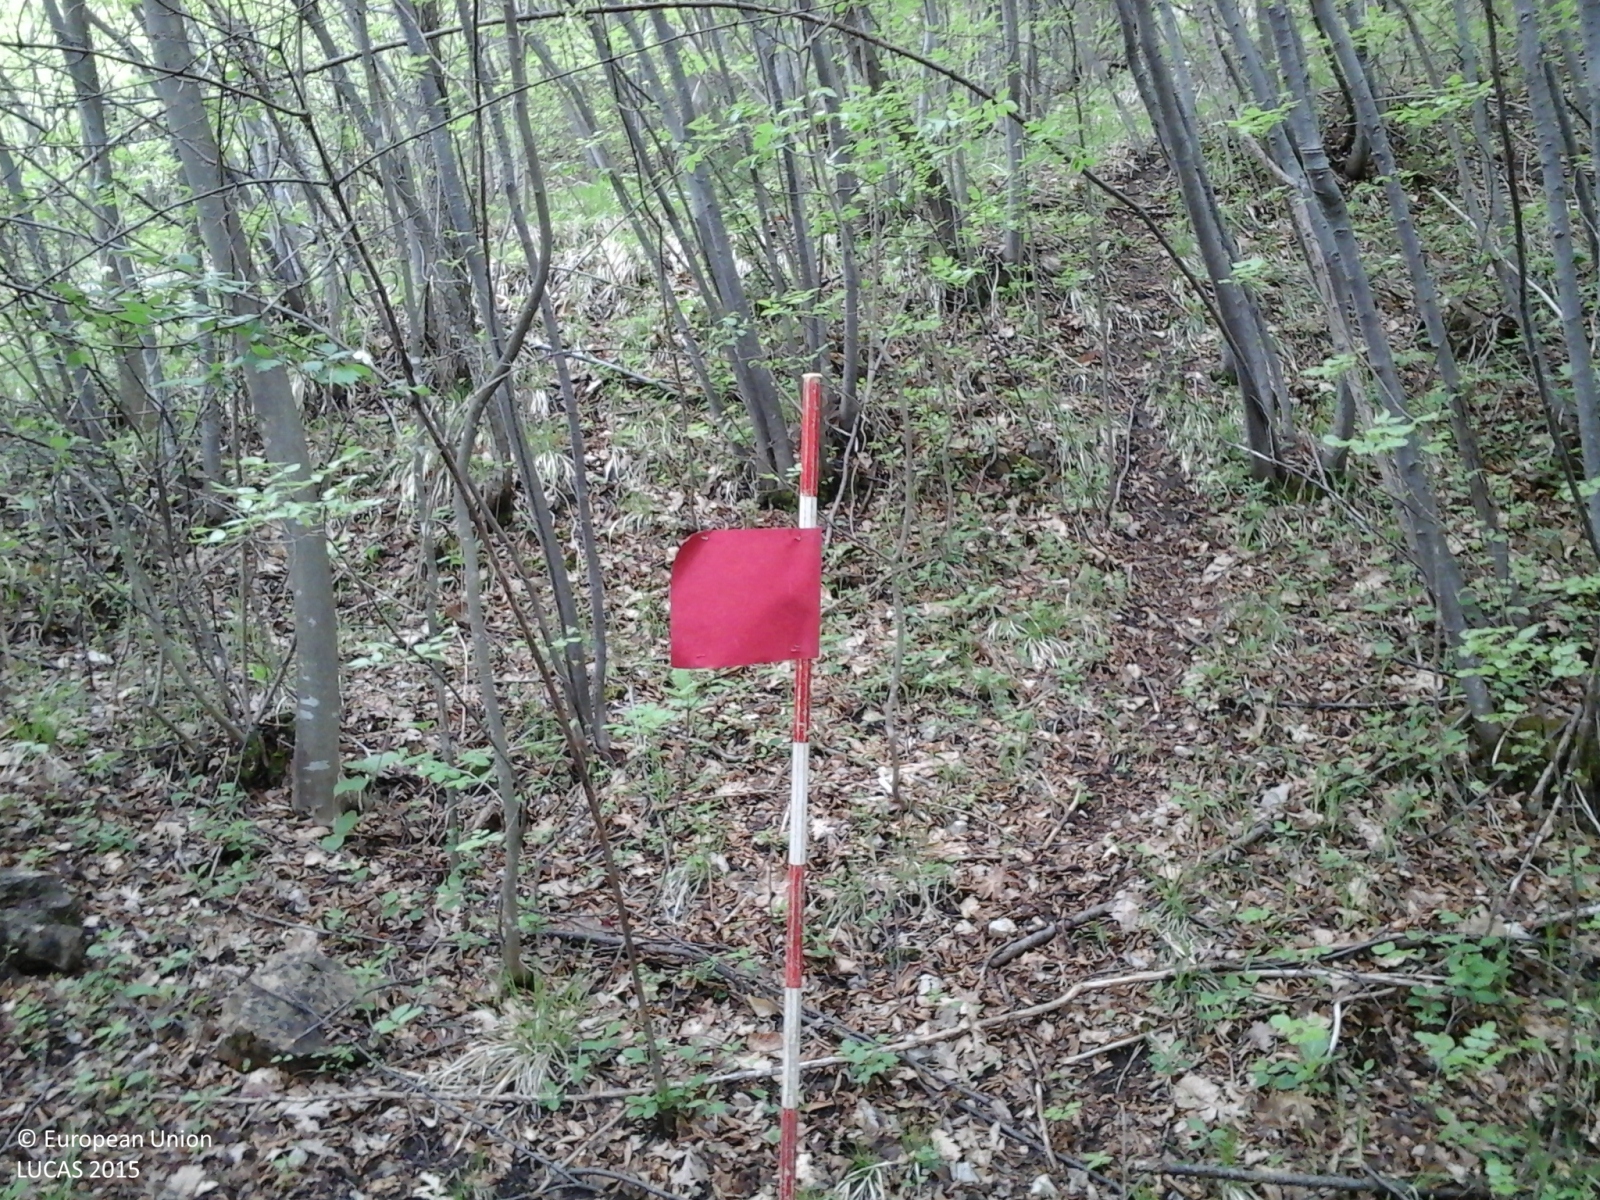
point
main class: Woodland
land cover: Broadleaved woodland
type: mesophytic deciduous forest
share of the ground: > 75 %
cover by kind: broadleaved forest trees 100 %
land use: Forestry
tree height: > 5 m
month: April
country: IT
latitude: 44.8532
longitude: 9.3055
